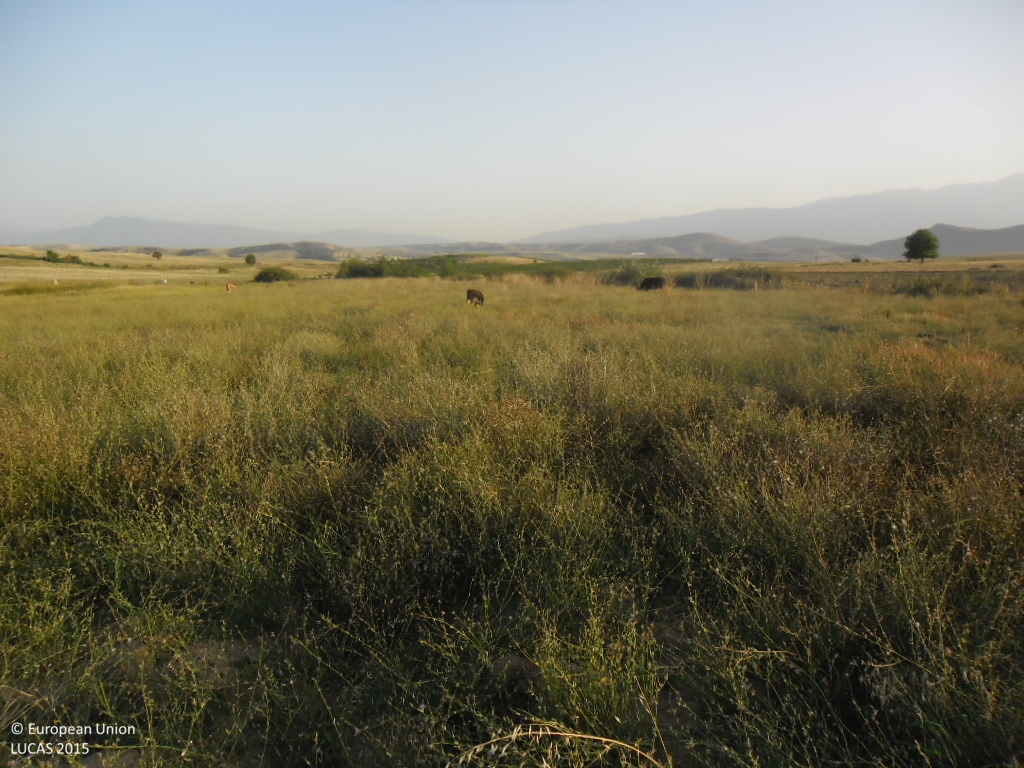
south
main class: Grassland
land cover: Grassland without tree/shrub cover
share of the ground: > 75 %
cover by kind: herbaceous plants 100 %
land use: Agriculture (excluding fallow land and kitchen gardens)
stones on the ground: < 10 %
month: September
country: BG
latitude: 41.5184
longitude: 23.2865
